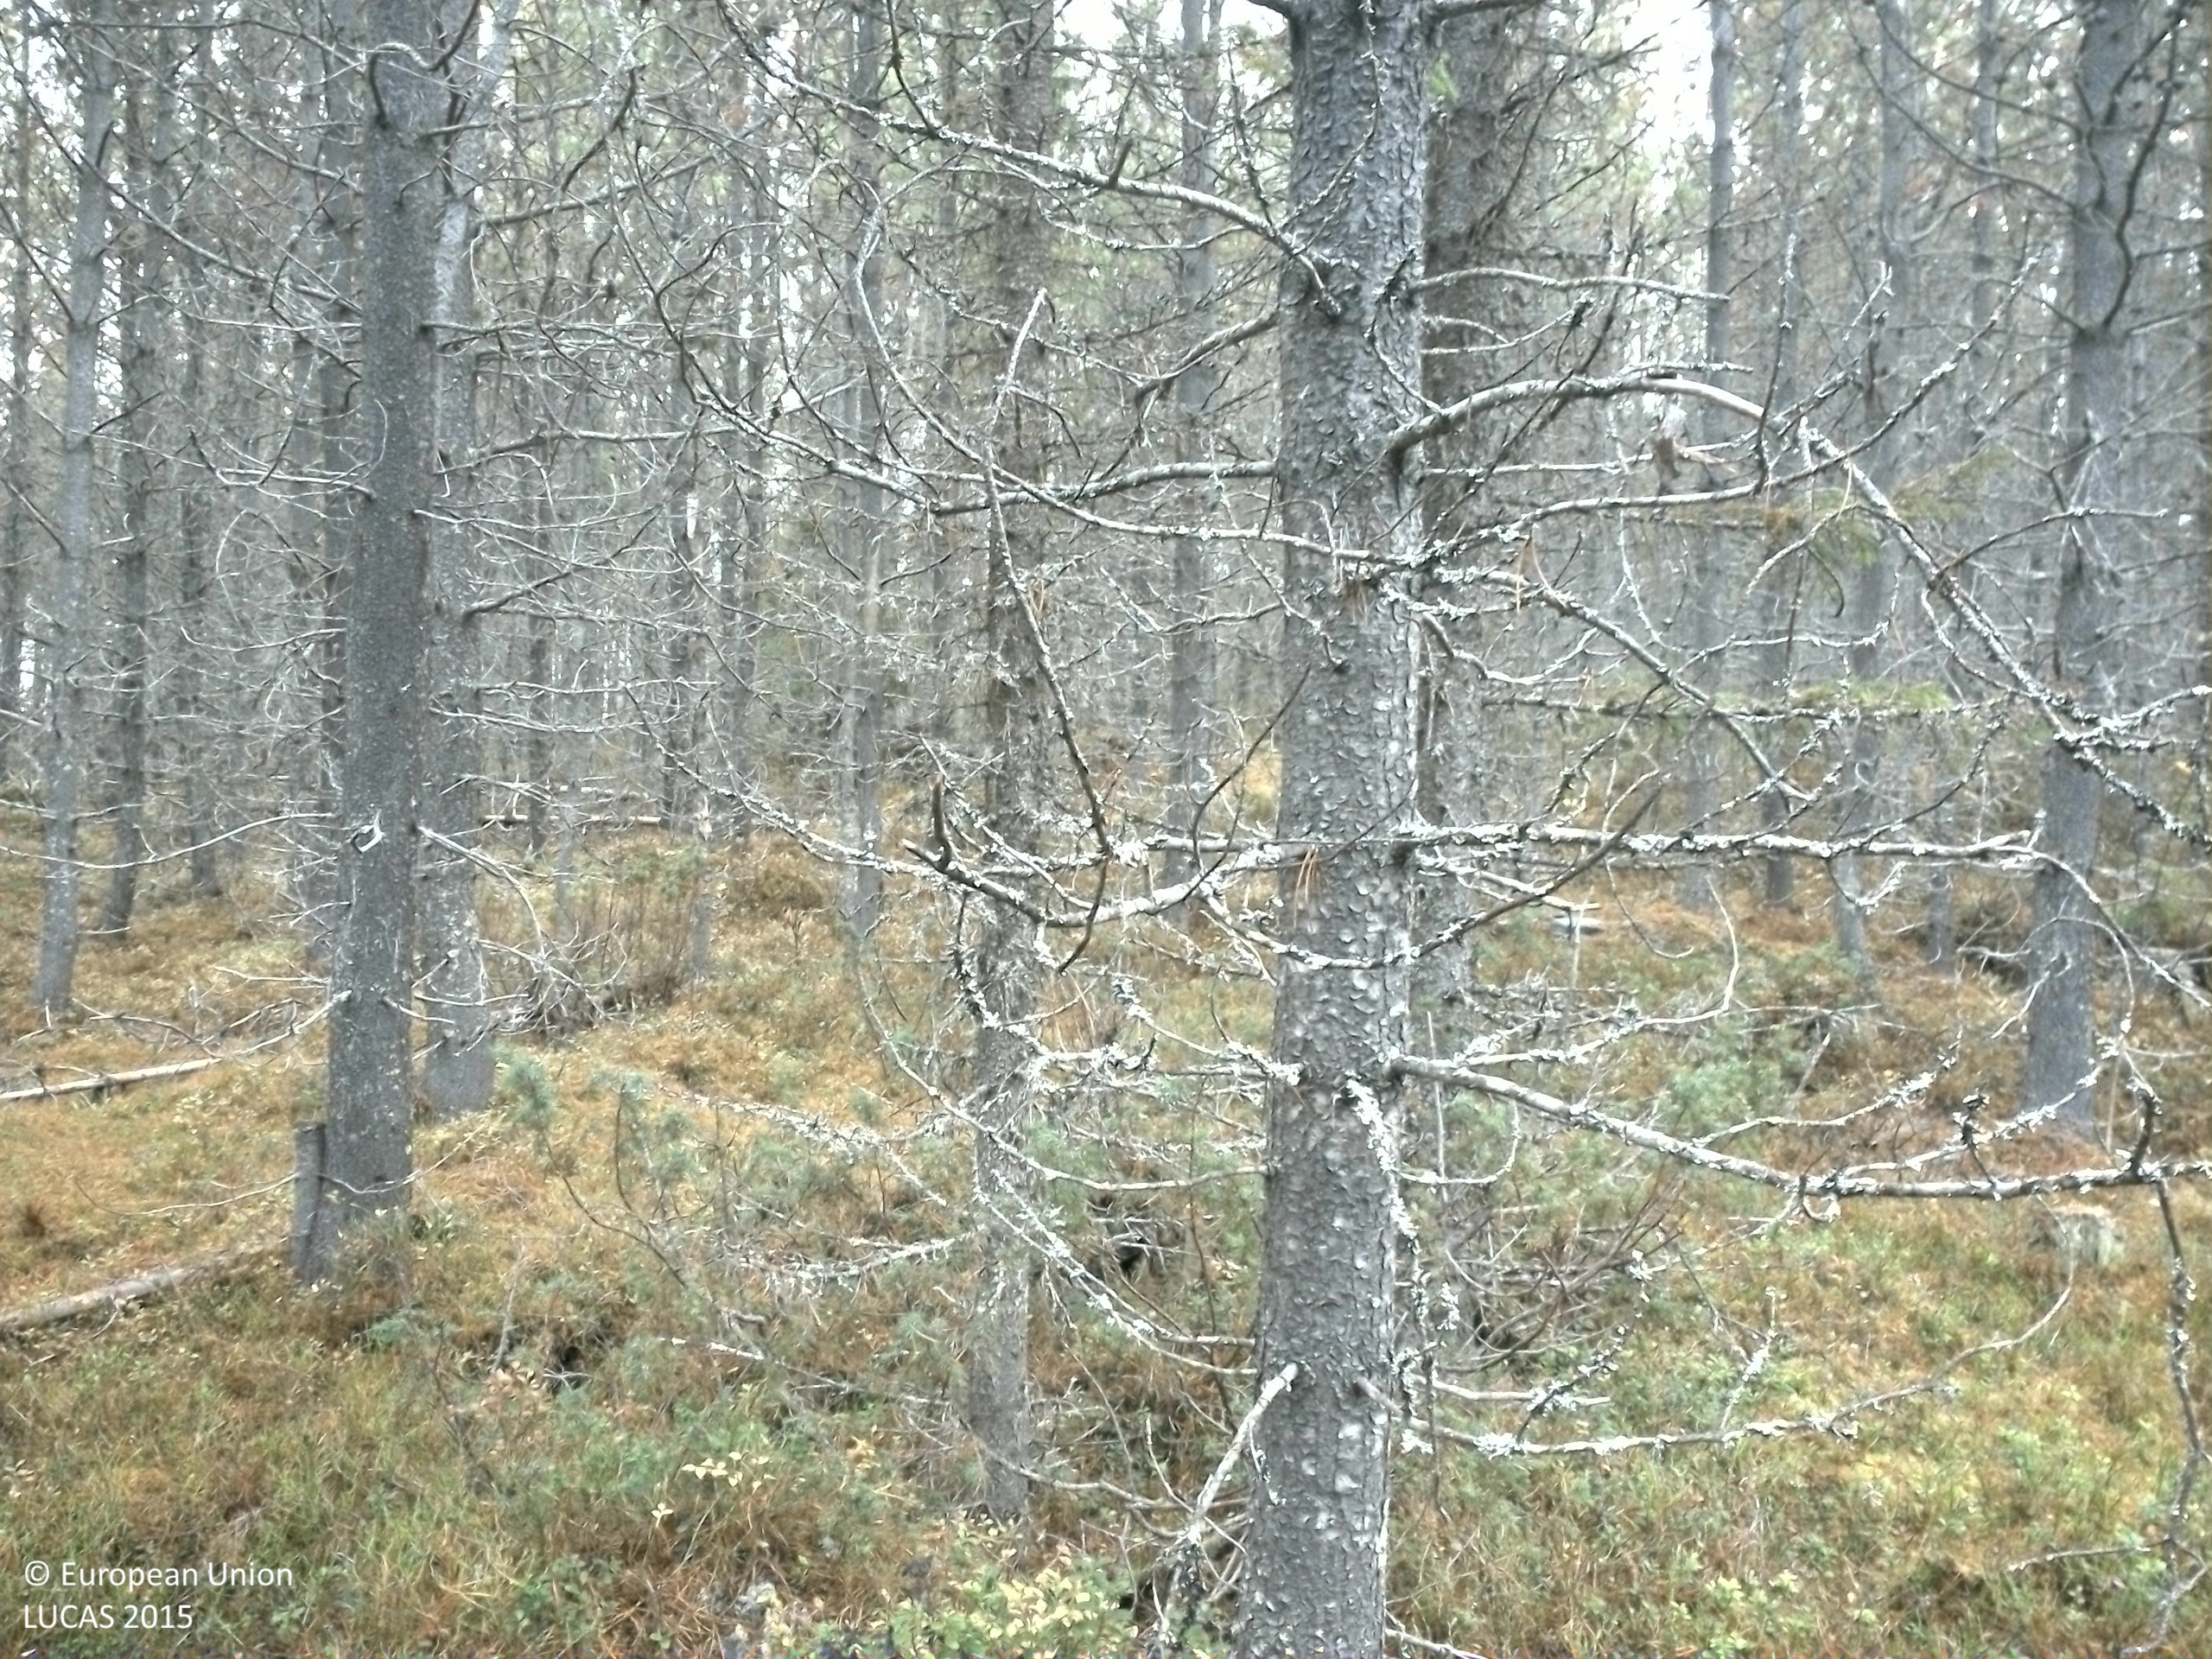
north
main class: Woodland
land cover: Pine dominated coniferous woodland
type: exotic forest
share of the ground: 25 - 50 %
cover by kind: coniferous forest trees 45 %, shrubs 35 %, lichens and mosses 15 %, unconsolidated bare surface 5 %
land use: Forestry
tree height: > 5 m
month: October
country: SE
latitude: 64.3046
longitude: 15.4491
